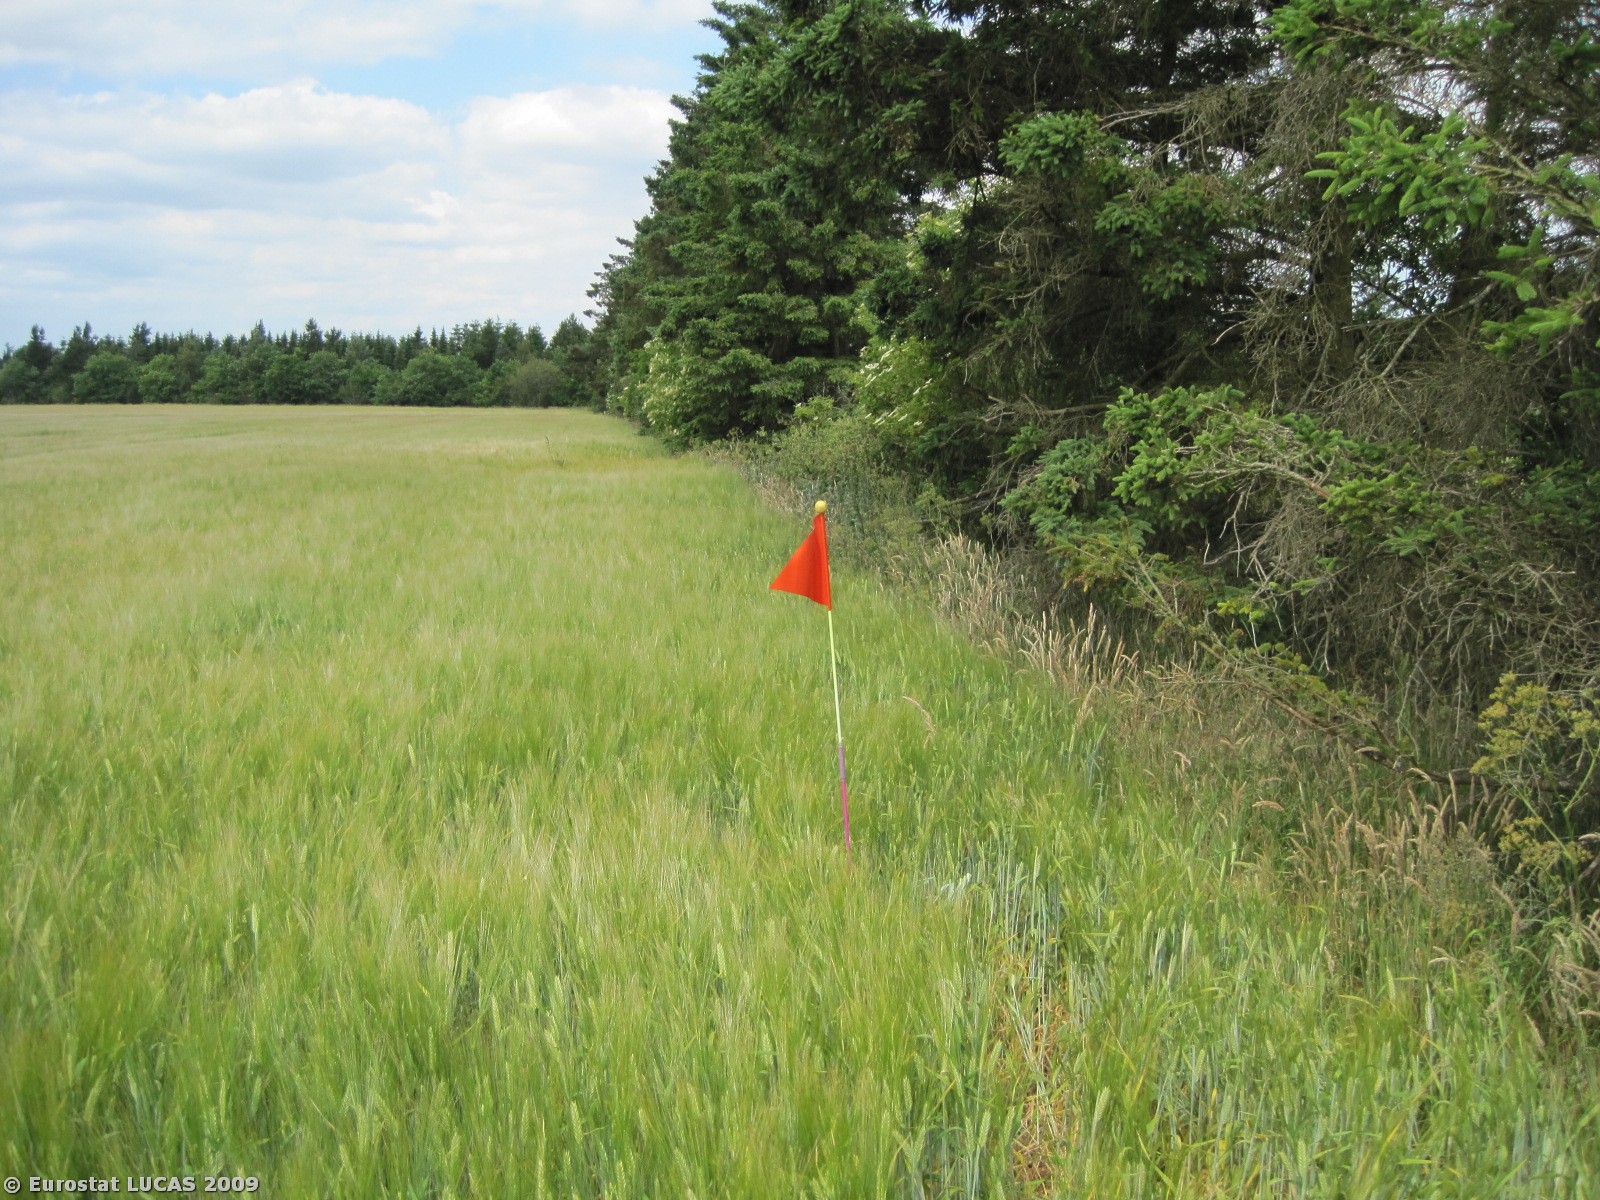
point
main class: Cropland
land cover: Barley
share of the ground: > 75 %
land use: Agriculture (excluding fallow land and kitchen gardens)
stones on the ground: < 10 %
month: June
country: DK
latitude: 56.3255
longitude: 8.7563
